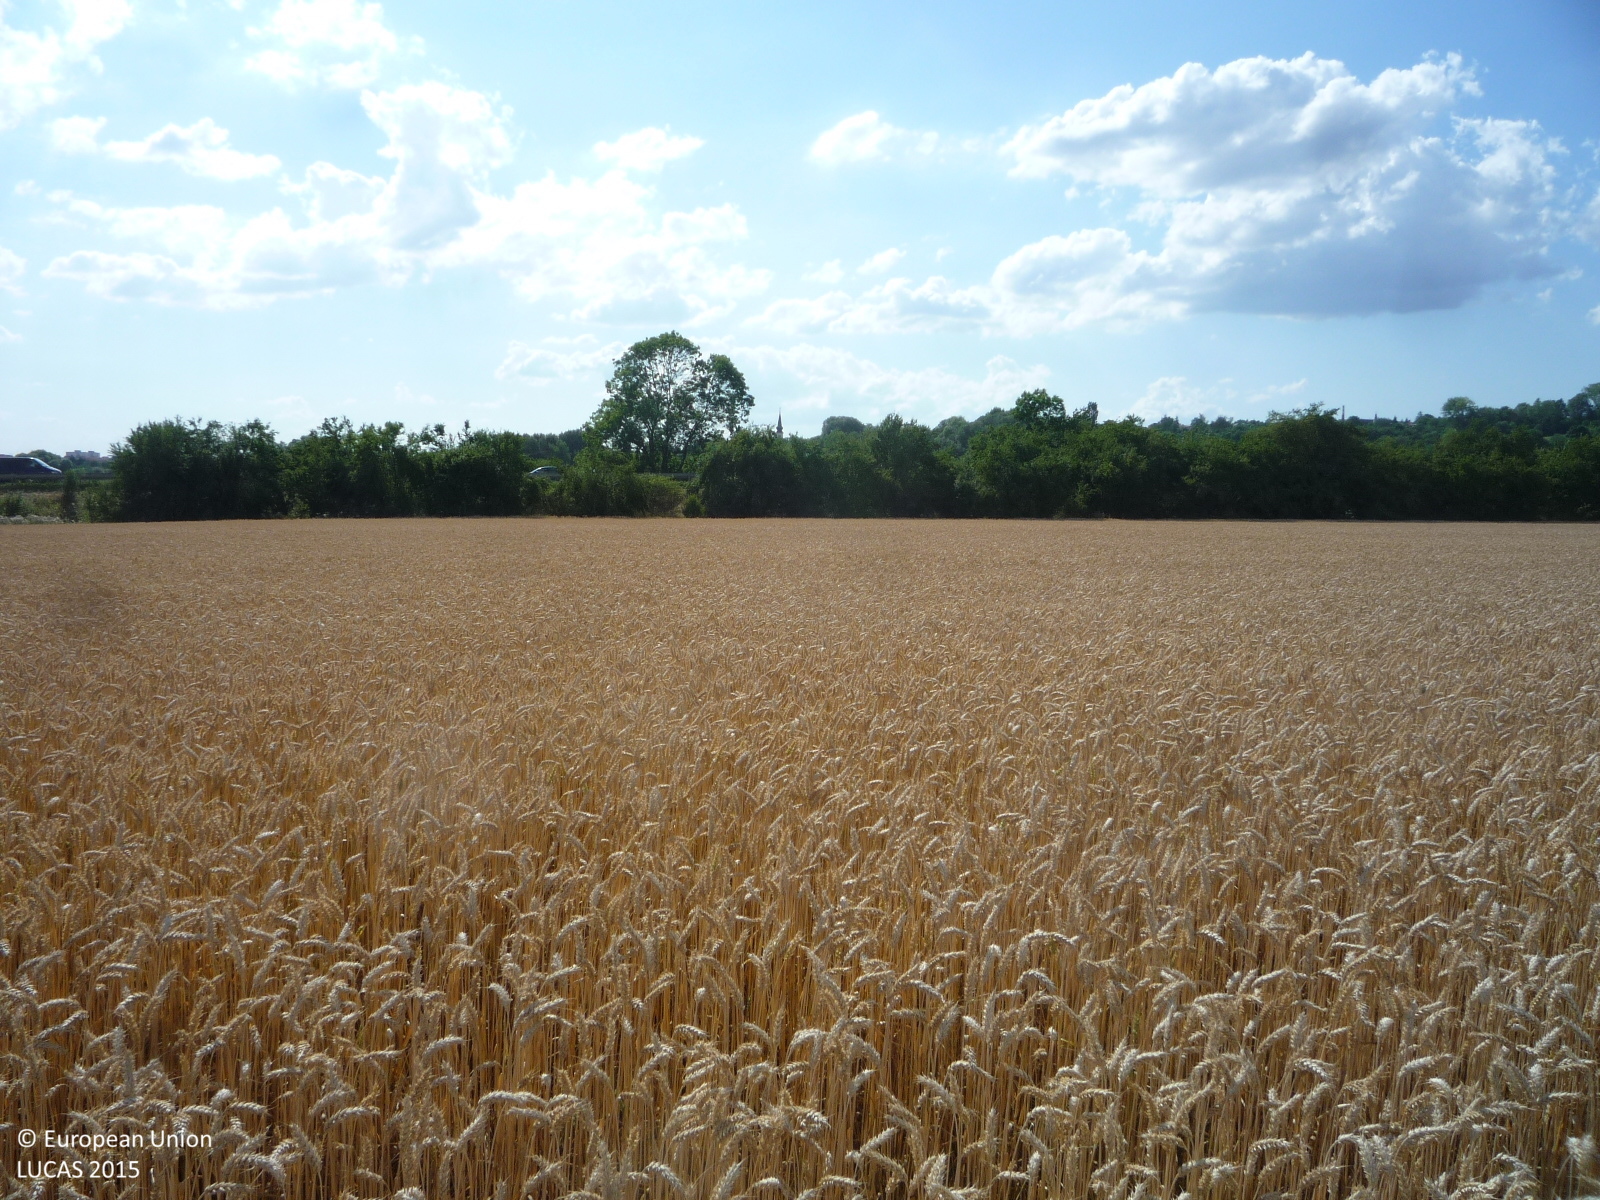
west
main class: Cropland
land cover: Common wheat
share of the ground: > 75 %
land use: Agriculture (excluding fallow land and kitchen gardens)
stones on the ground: < 10 %
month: July
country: CZ
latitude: 50.4373
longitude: 14.9447
